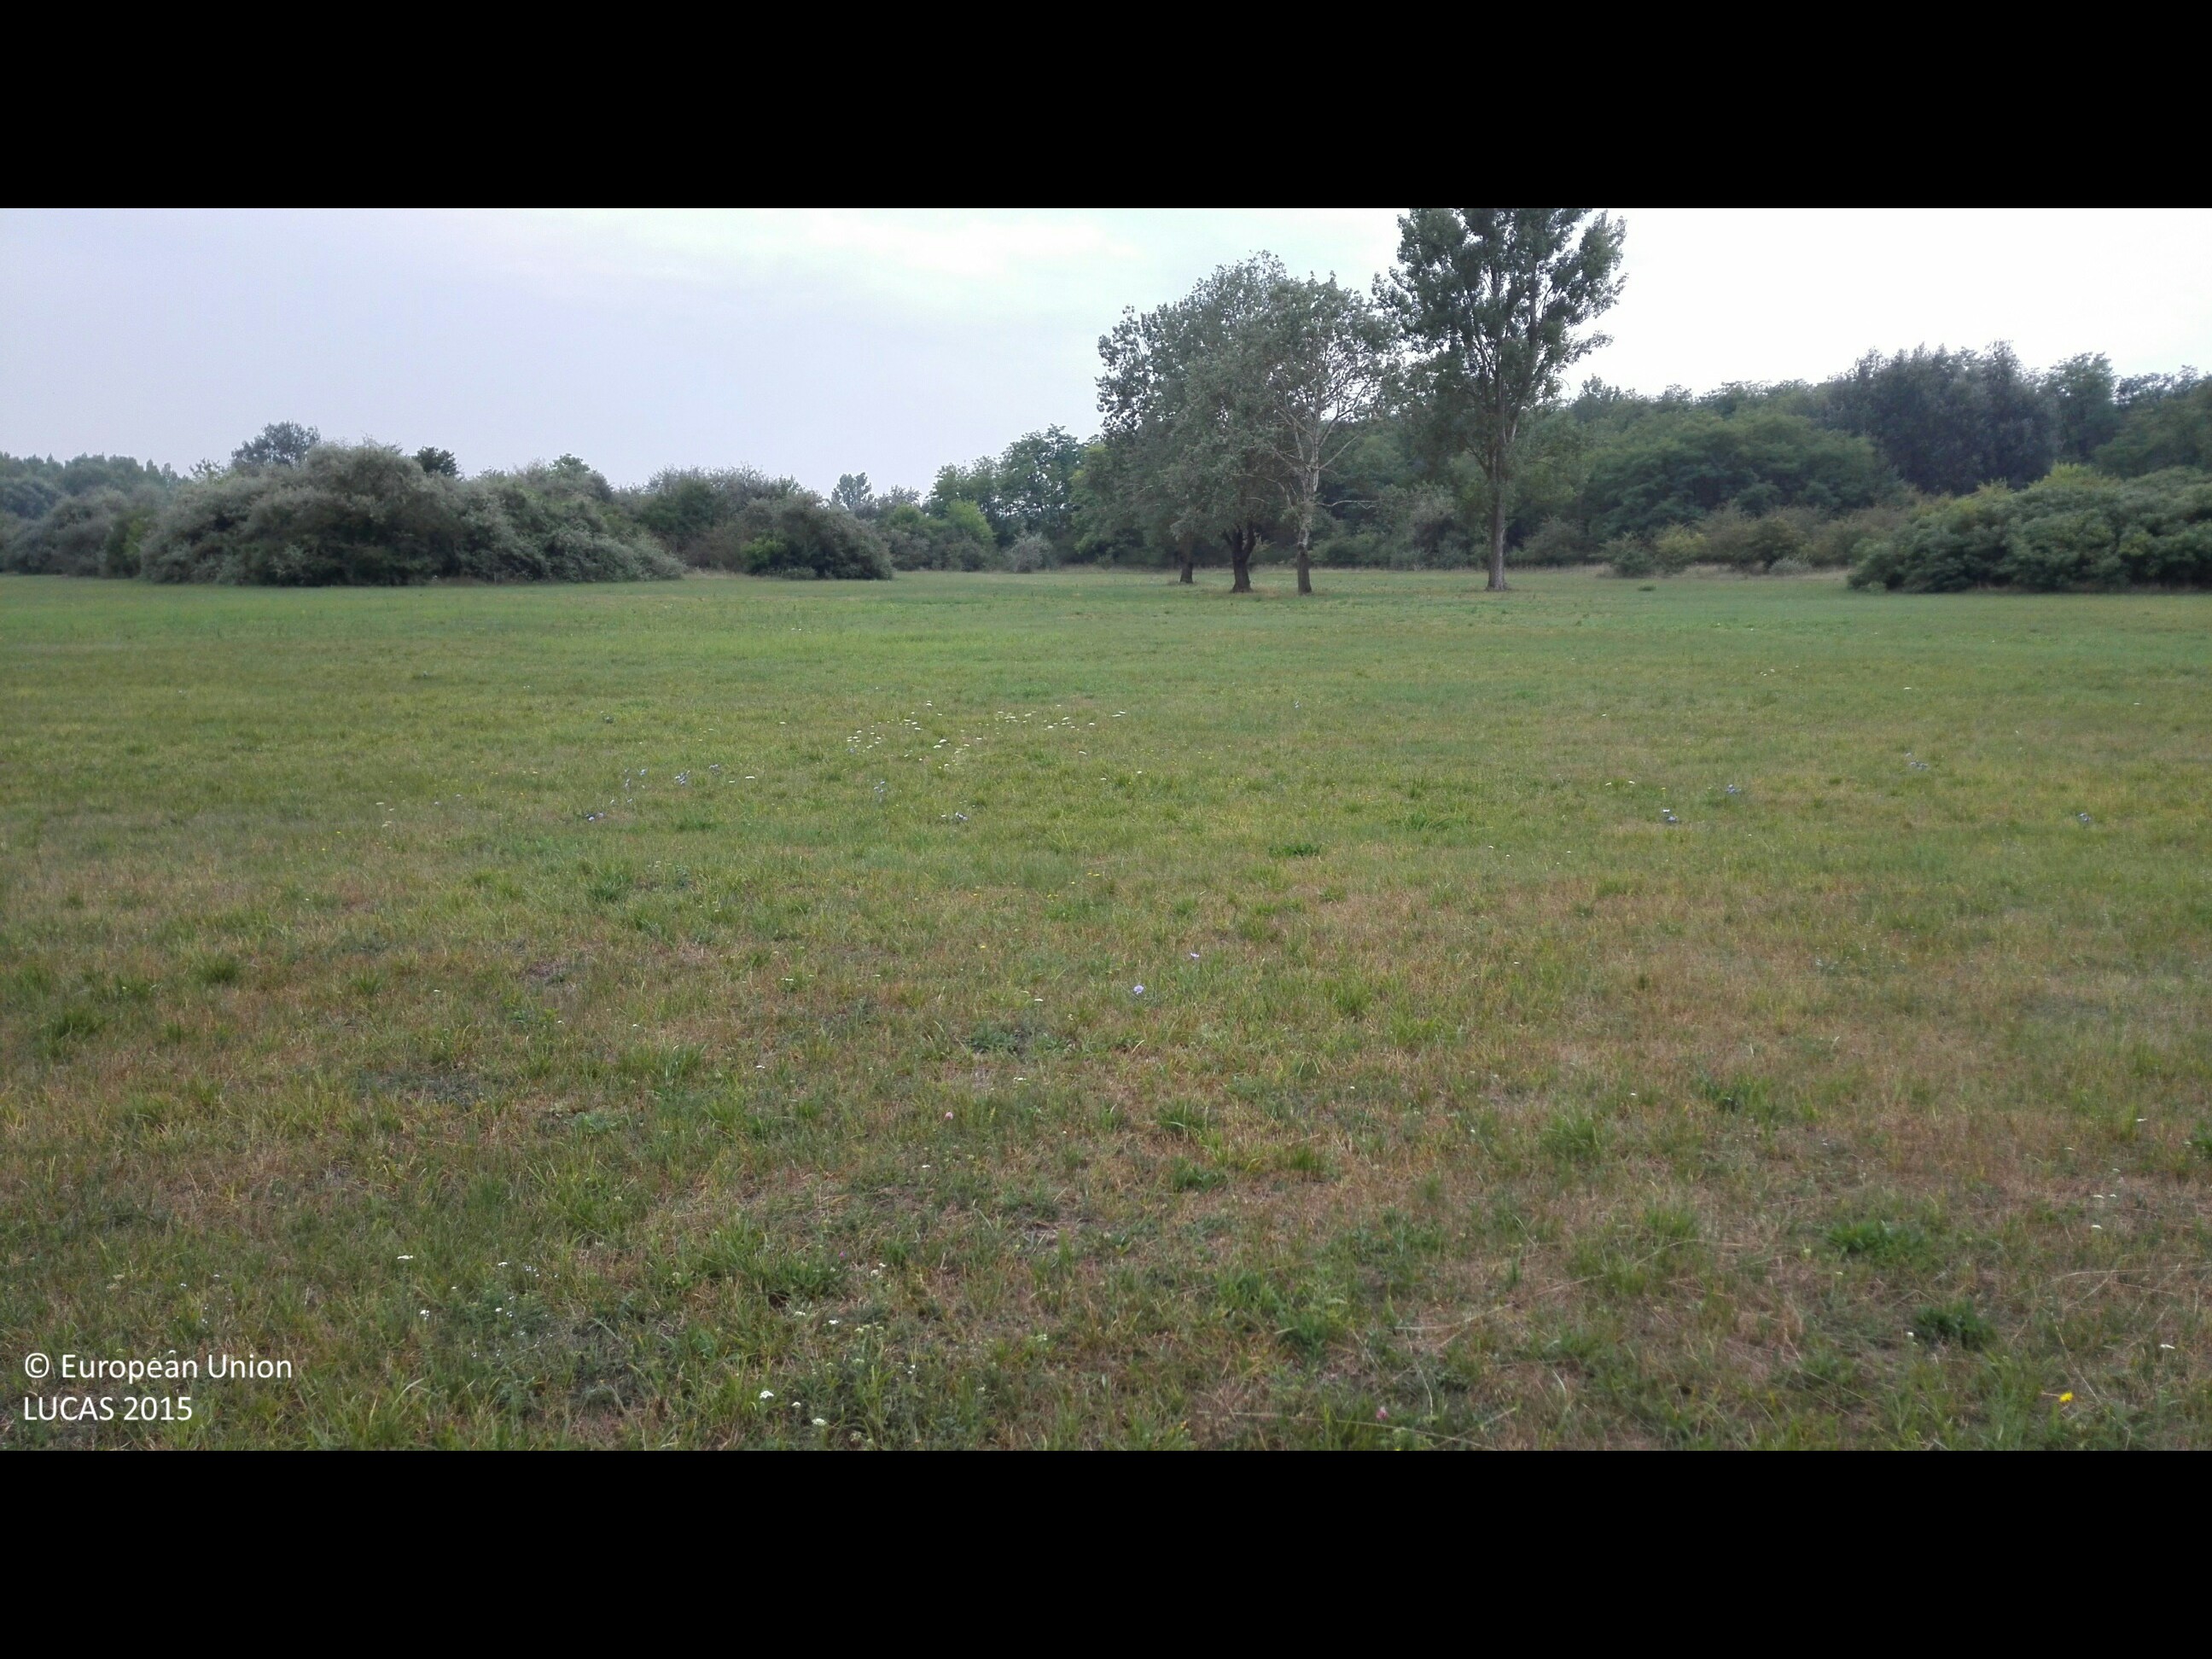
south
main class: Grassland
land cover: Grassland without tree/shrub cover
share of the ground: > 75 %
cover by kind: herbaceous plants 100 %
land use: Agriculture (excluding fallow land and kitchen gardens)
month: August
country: HU
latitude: 47.5410
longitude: 21.7239
